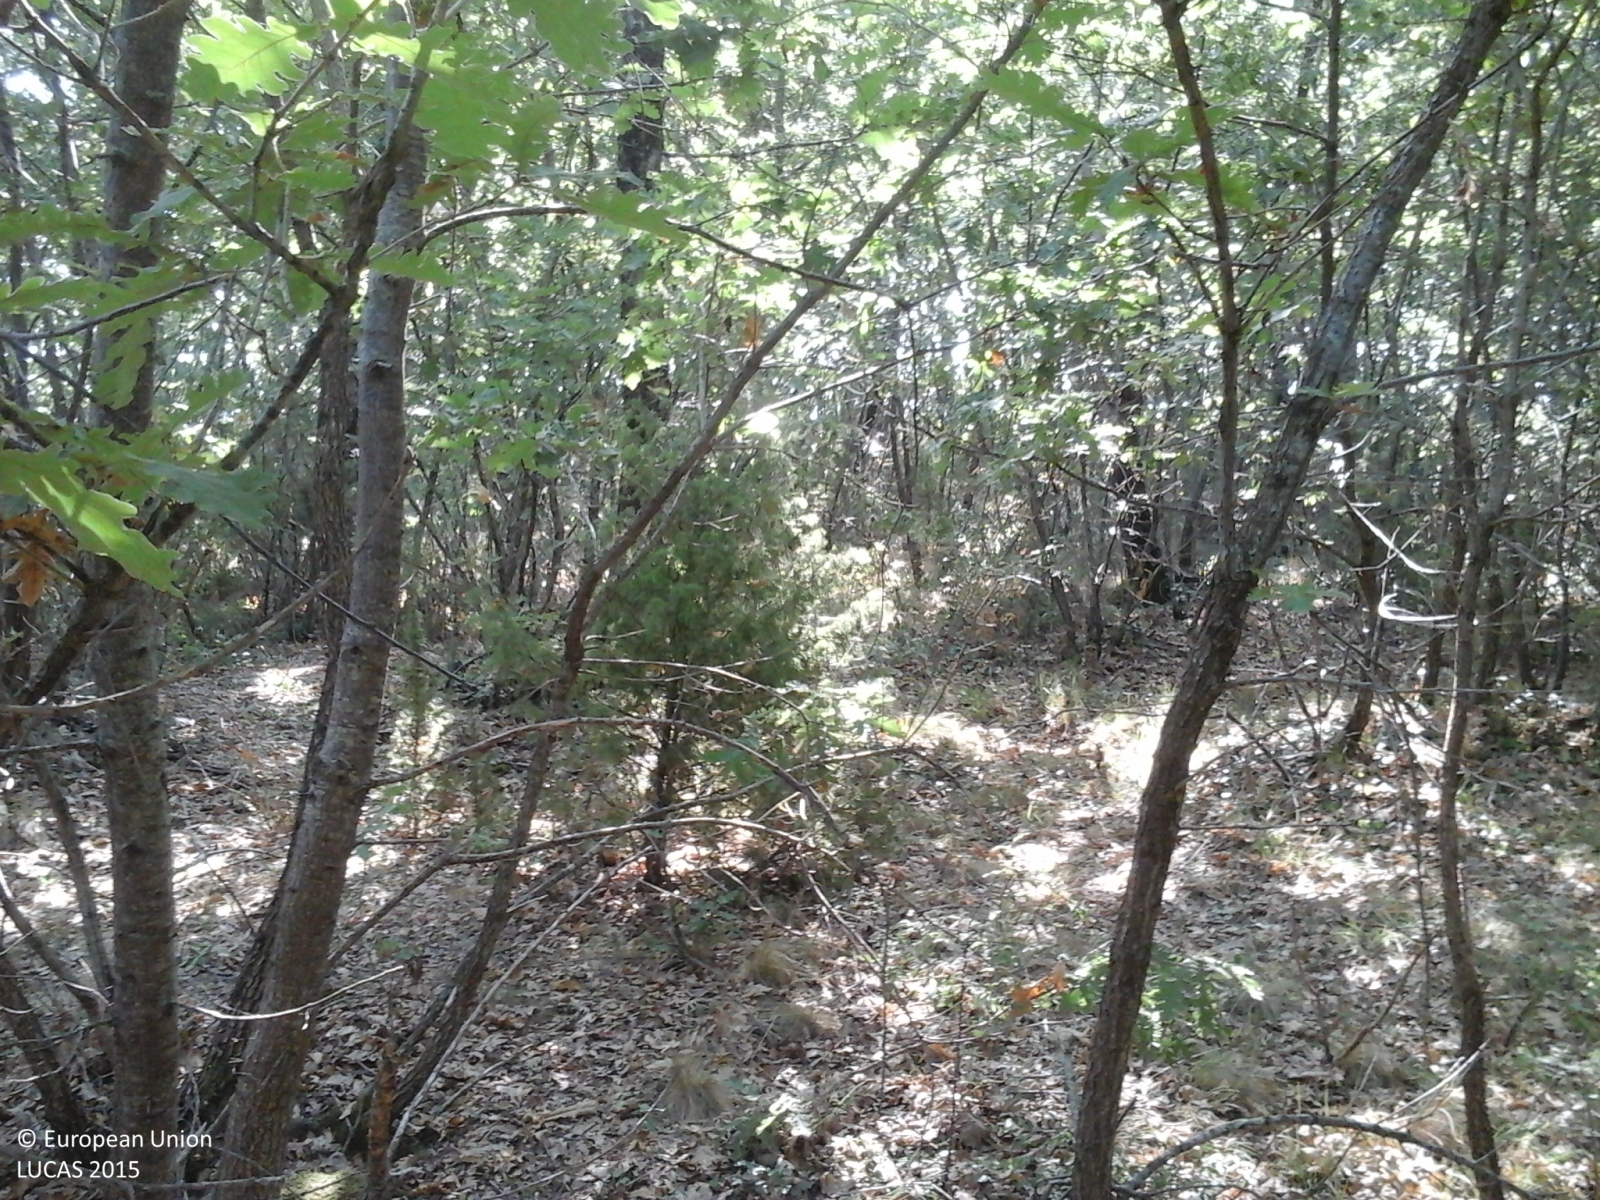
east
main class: Woodland
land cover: Broadleaved woodland
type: thermophilous deciduous forest
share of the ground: > 75 %
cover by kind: broadleaved forest trees 100 %
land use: Forestry
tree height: > 5 m
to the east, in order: Broadleaved woodland; Common wheat; Tracks; Other leguminous and mixtures for fodder
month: July
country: IT
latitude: 42.6426
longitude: 12.4436
